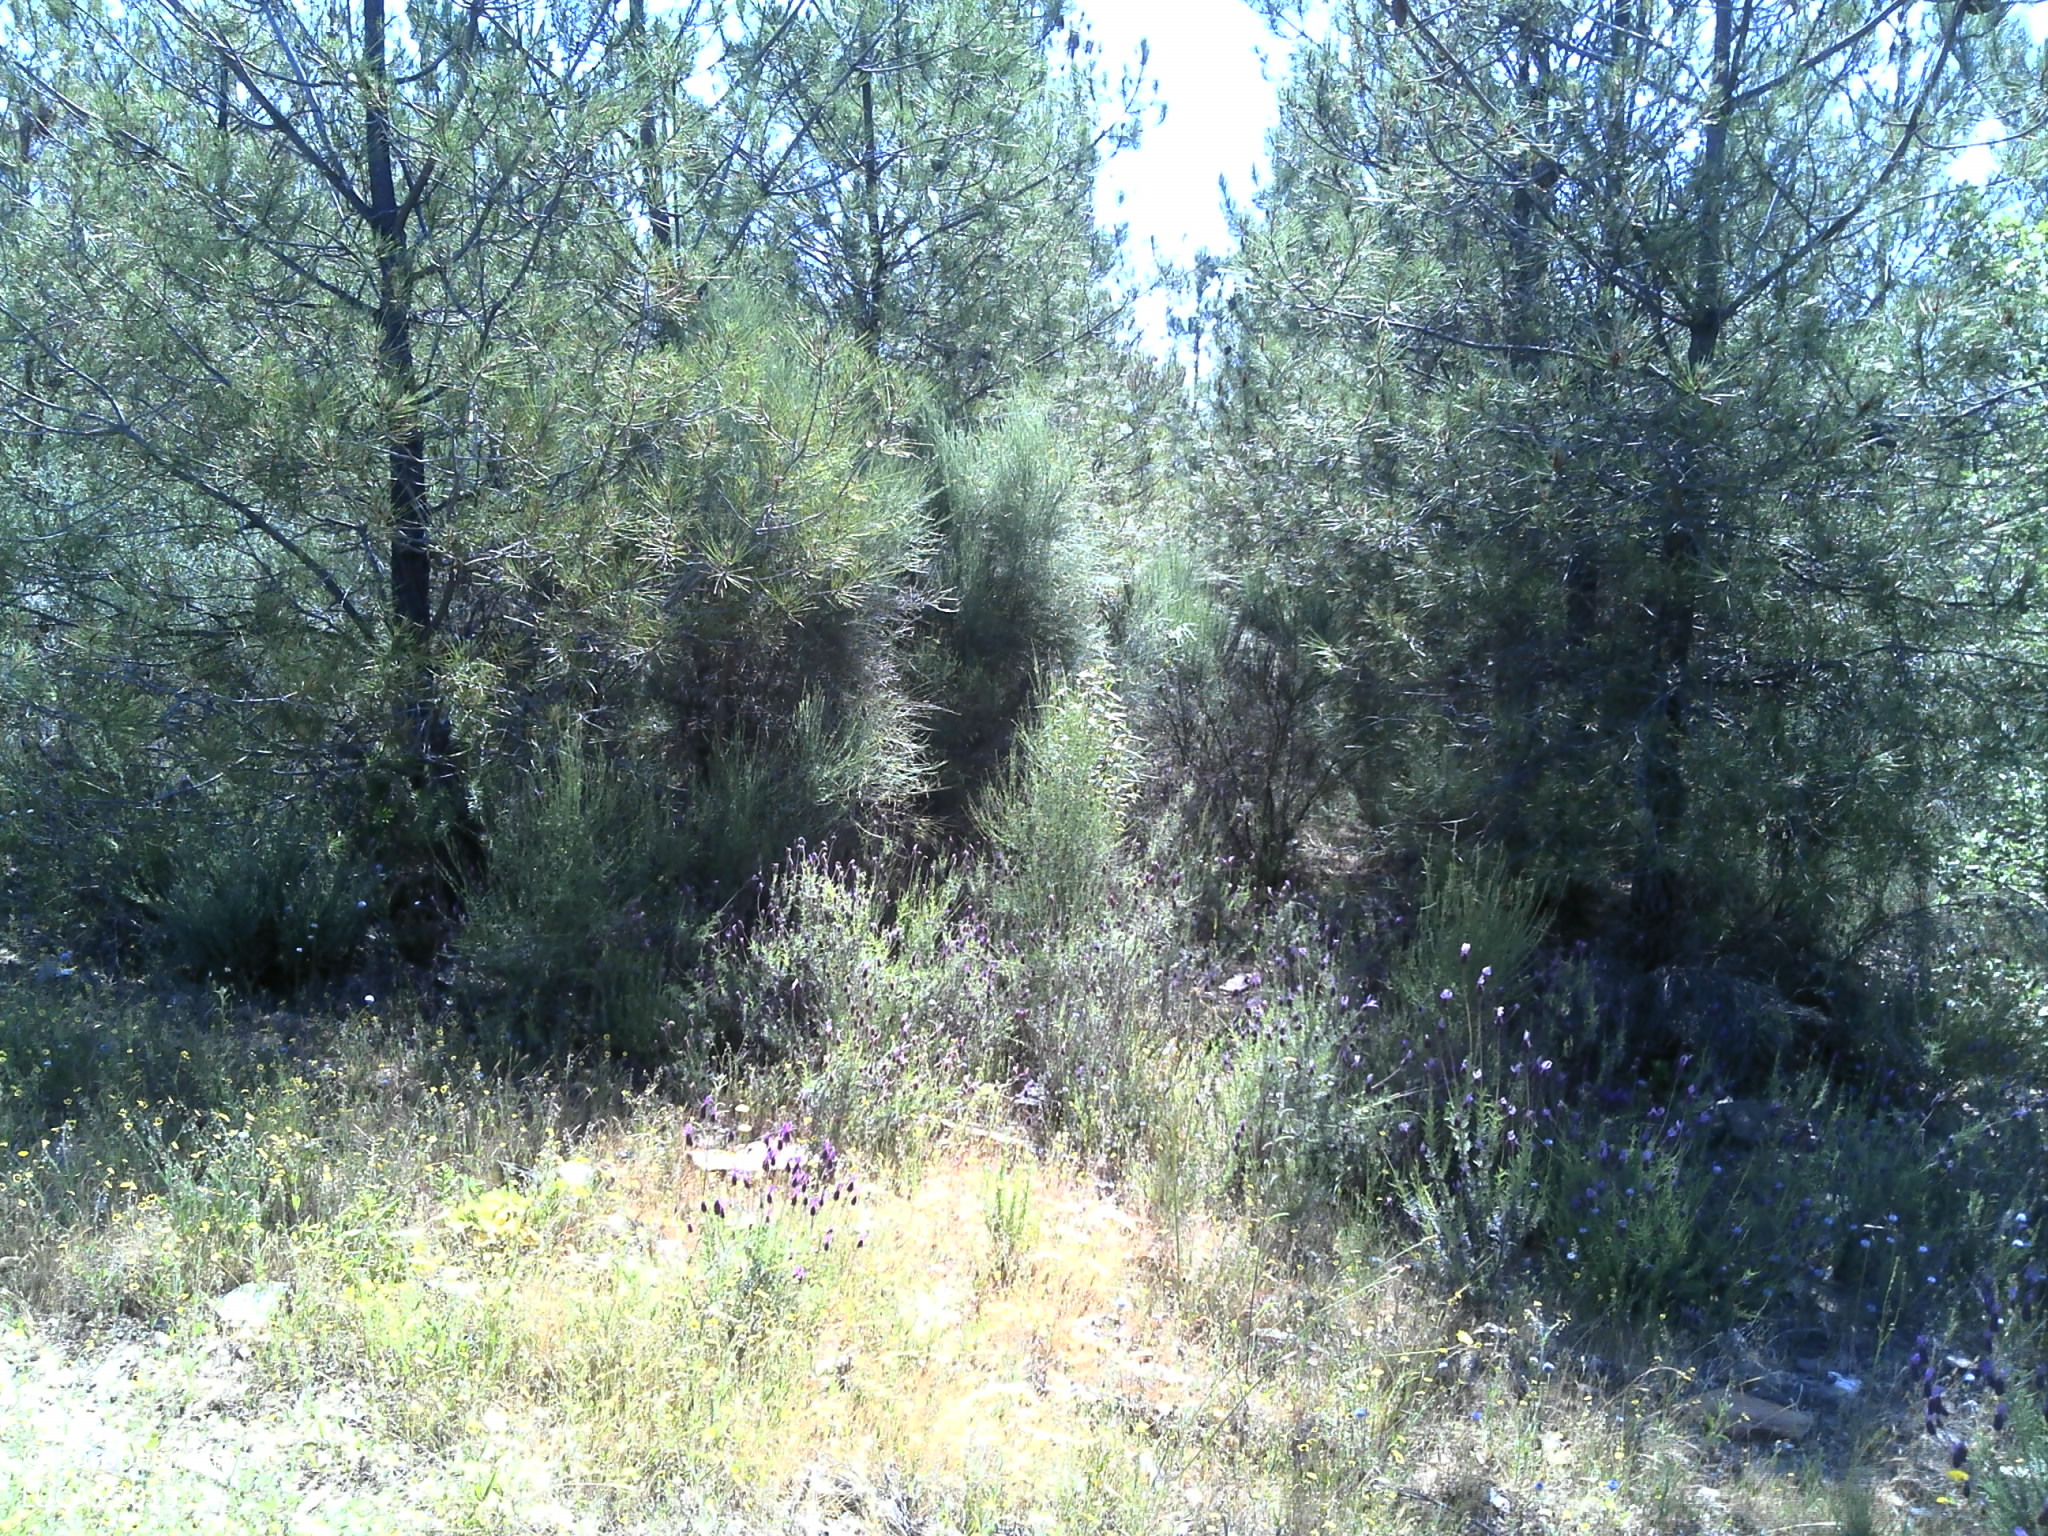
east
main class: Shrubland
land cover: Shrubland with sparse tree cover
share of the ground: > 75 %
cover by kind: shrubs 95 %, broadleaved forest trees 5 %
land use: Abandoned areas
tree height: > 5 m
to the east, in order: Shrubland with sparse tree cover; Tracks; Pine dominated coniferous woodland; Shrubland with sparse tree cover
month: May
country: PT
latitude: 41.1218
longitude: -6.8391
